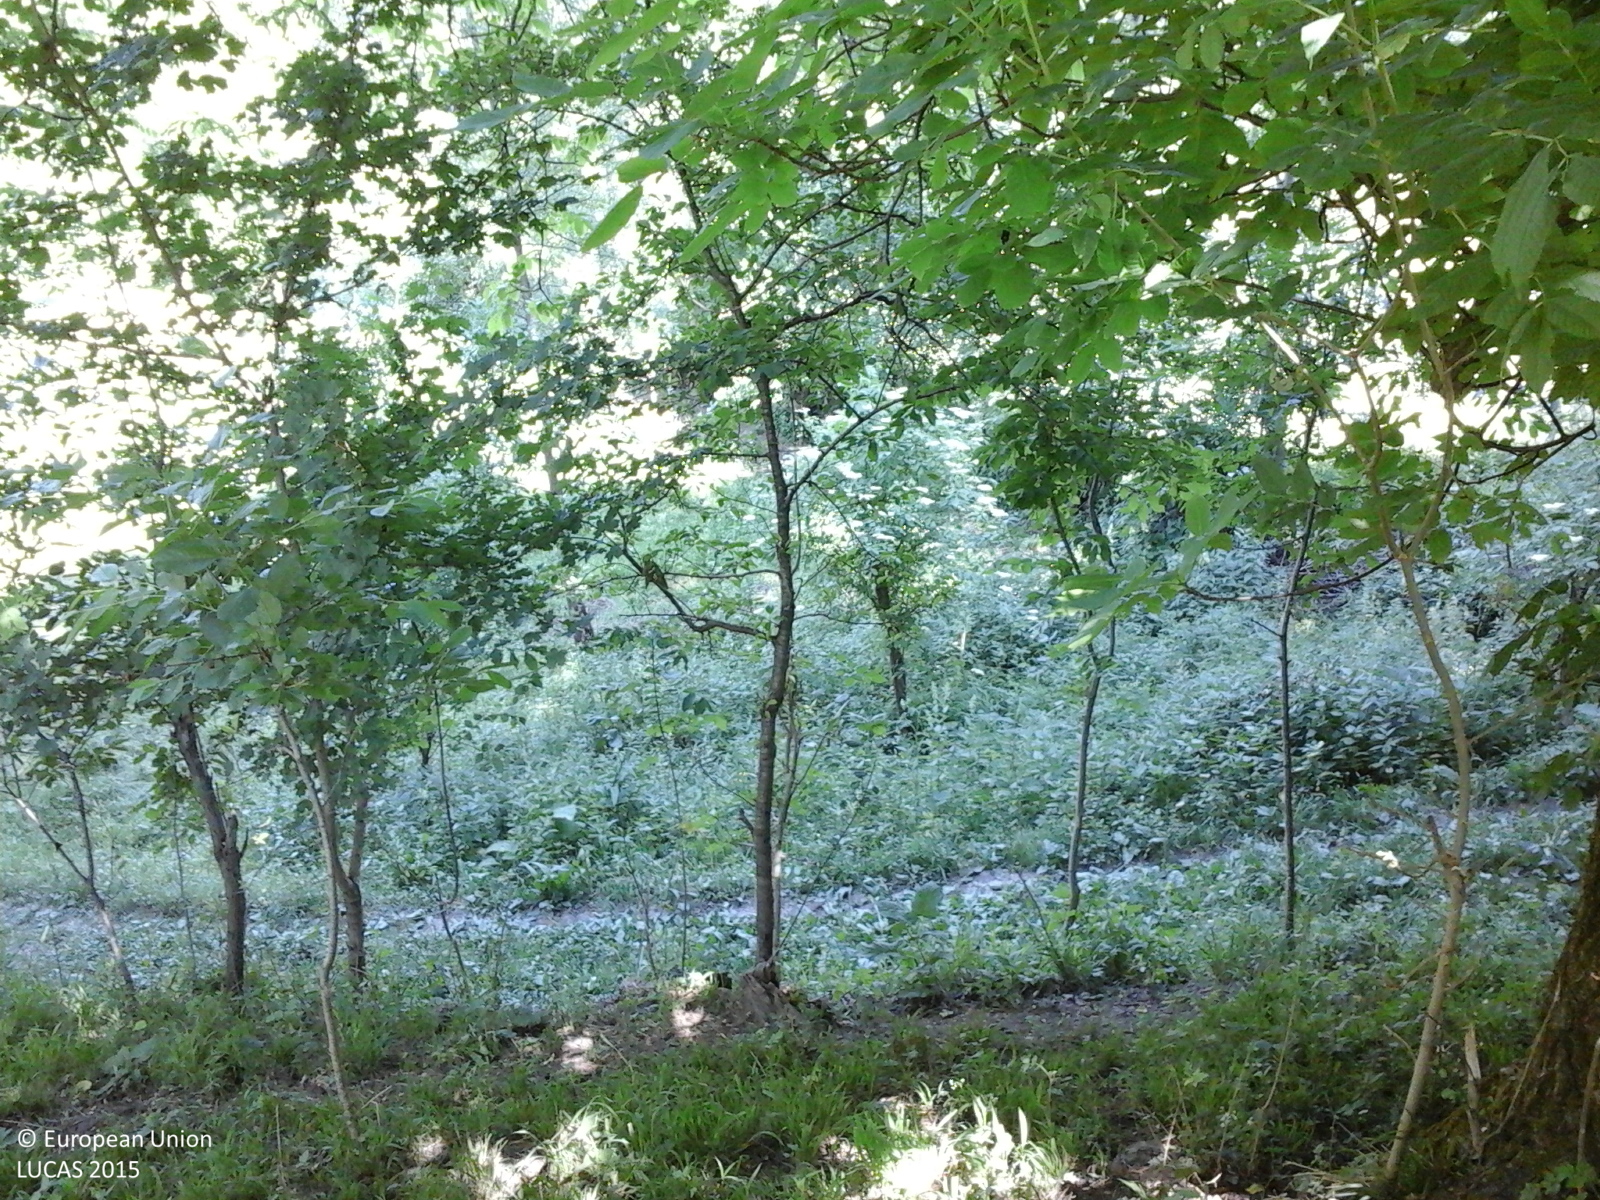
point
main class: Grassland
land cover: Grassland with sparse tree/shrub cover
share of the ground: > 75 %
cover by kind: herbaceous plants 85 %, shrubs 10 %, broadleaved forest trees 5 %
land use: Agriculture (excluding fallow land and kitchen gardens)
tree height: > 5 m
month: June
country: RO
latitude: 45.1900
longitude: 25.7727
